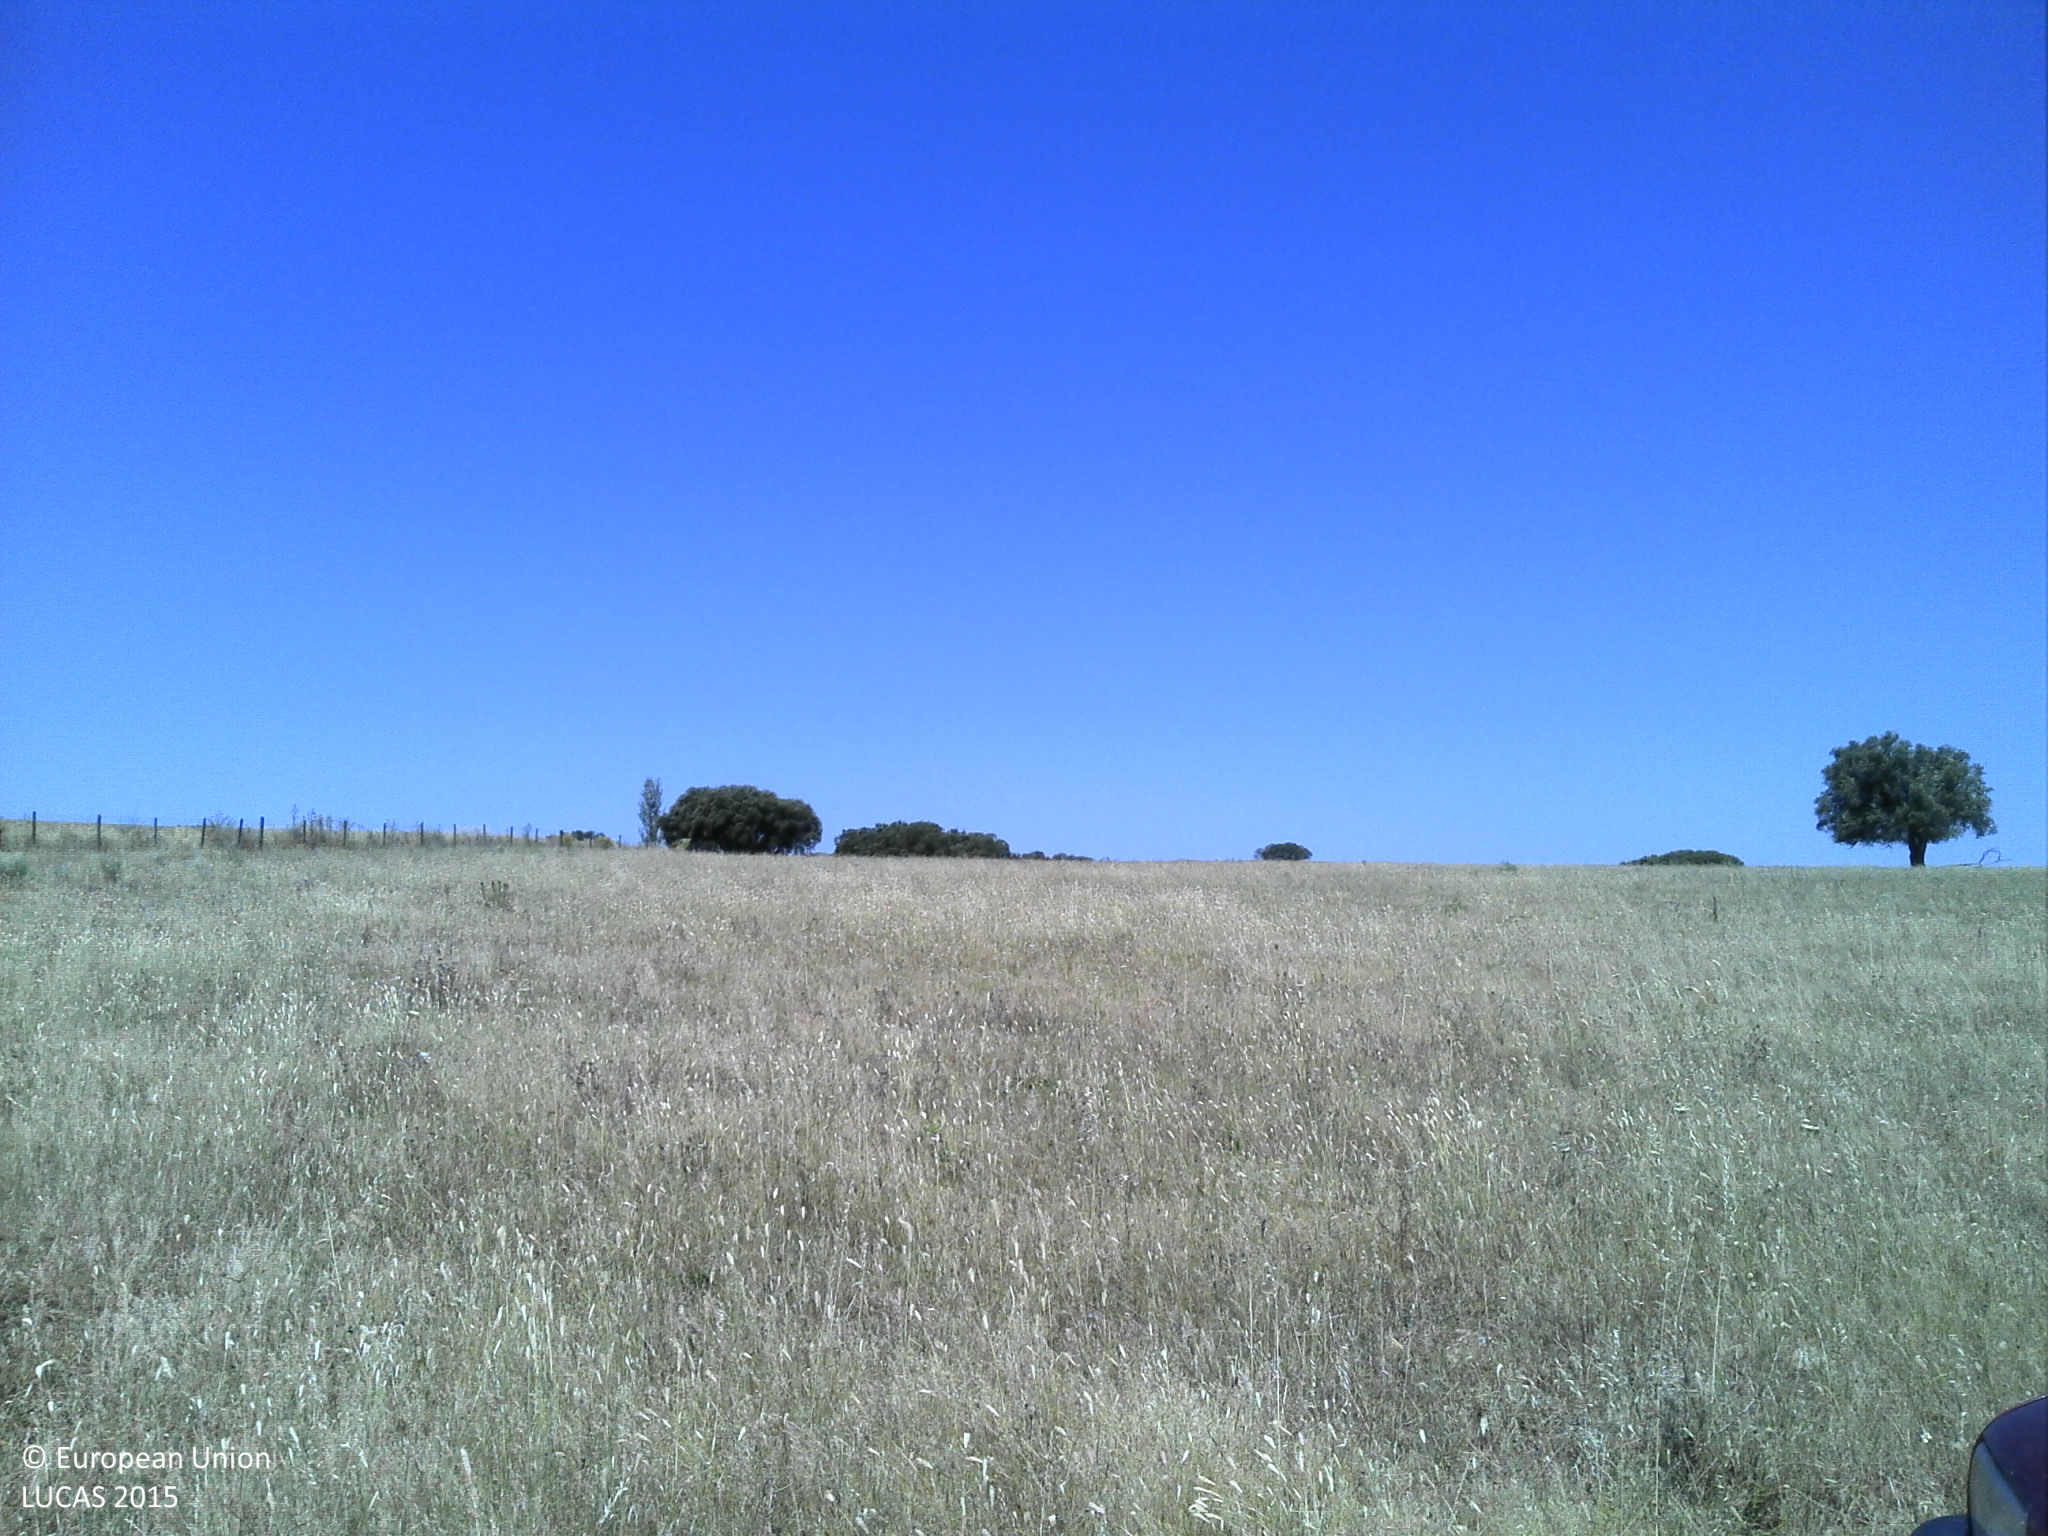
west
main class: Grassland
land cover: Grassland without tree/shrub cover
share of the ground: > 75 %
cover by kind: herbaceous plants 80 %, unconsolidated bare surface 20 %
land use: Agriculture (excluding fallow land and kitchen gardens)
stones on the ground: < 10 %
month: May
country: PT
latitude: 39.0295
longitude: -7.6107
